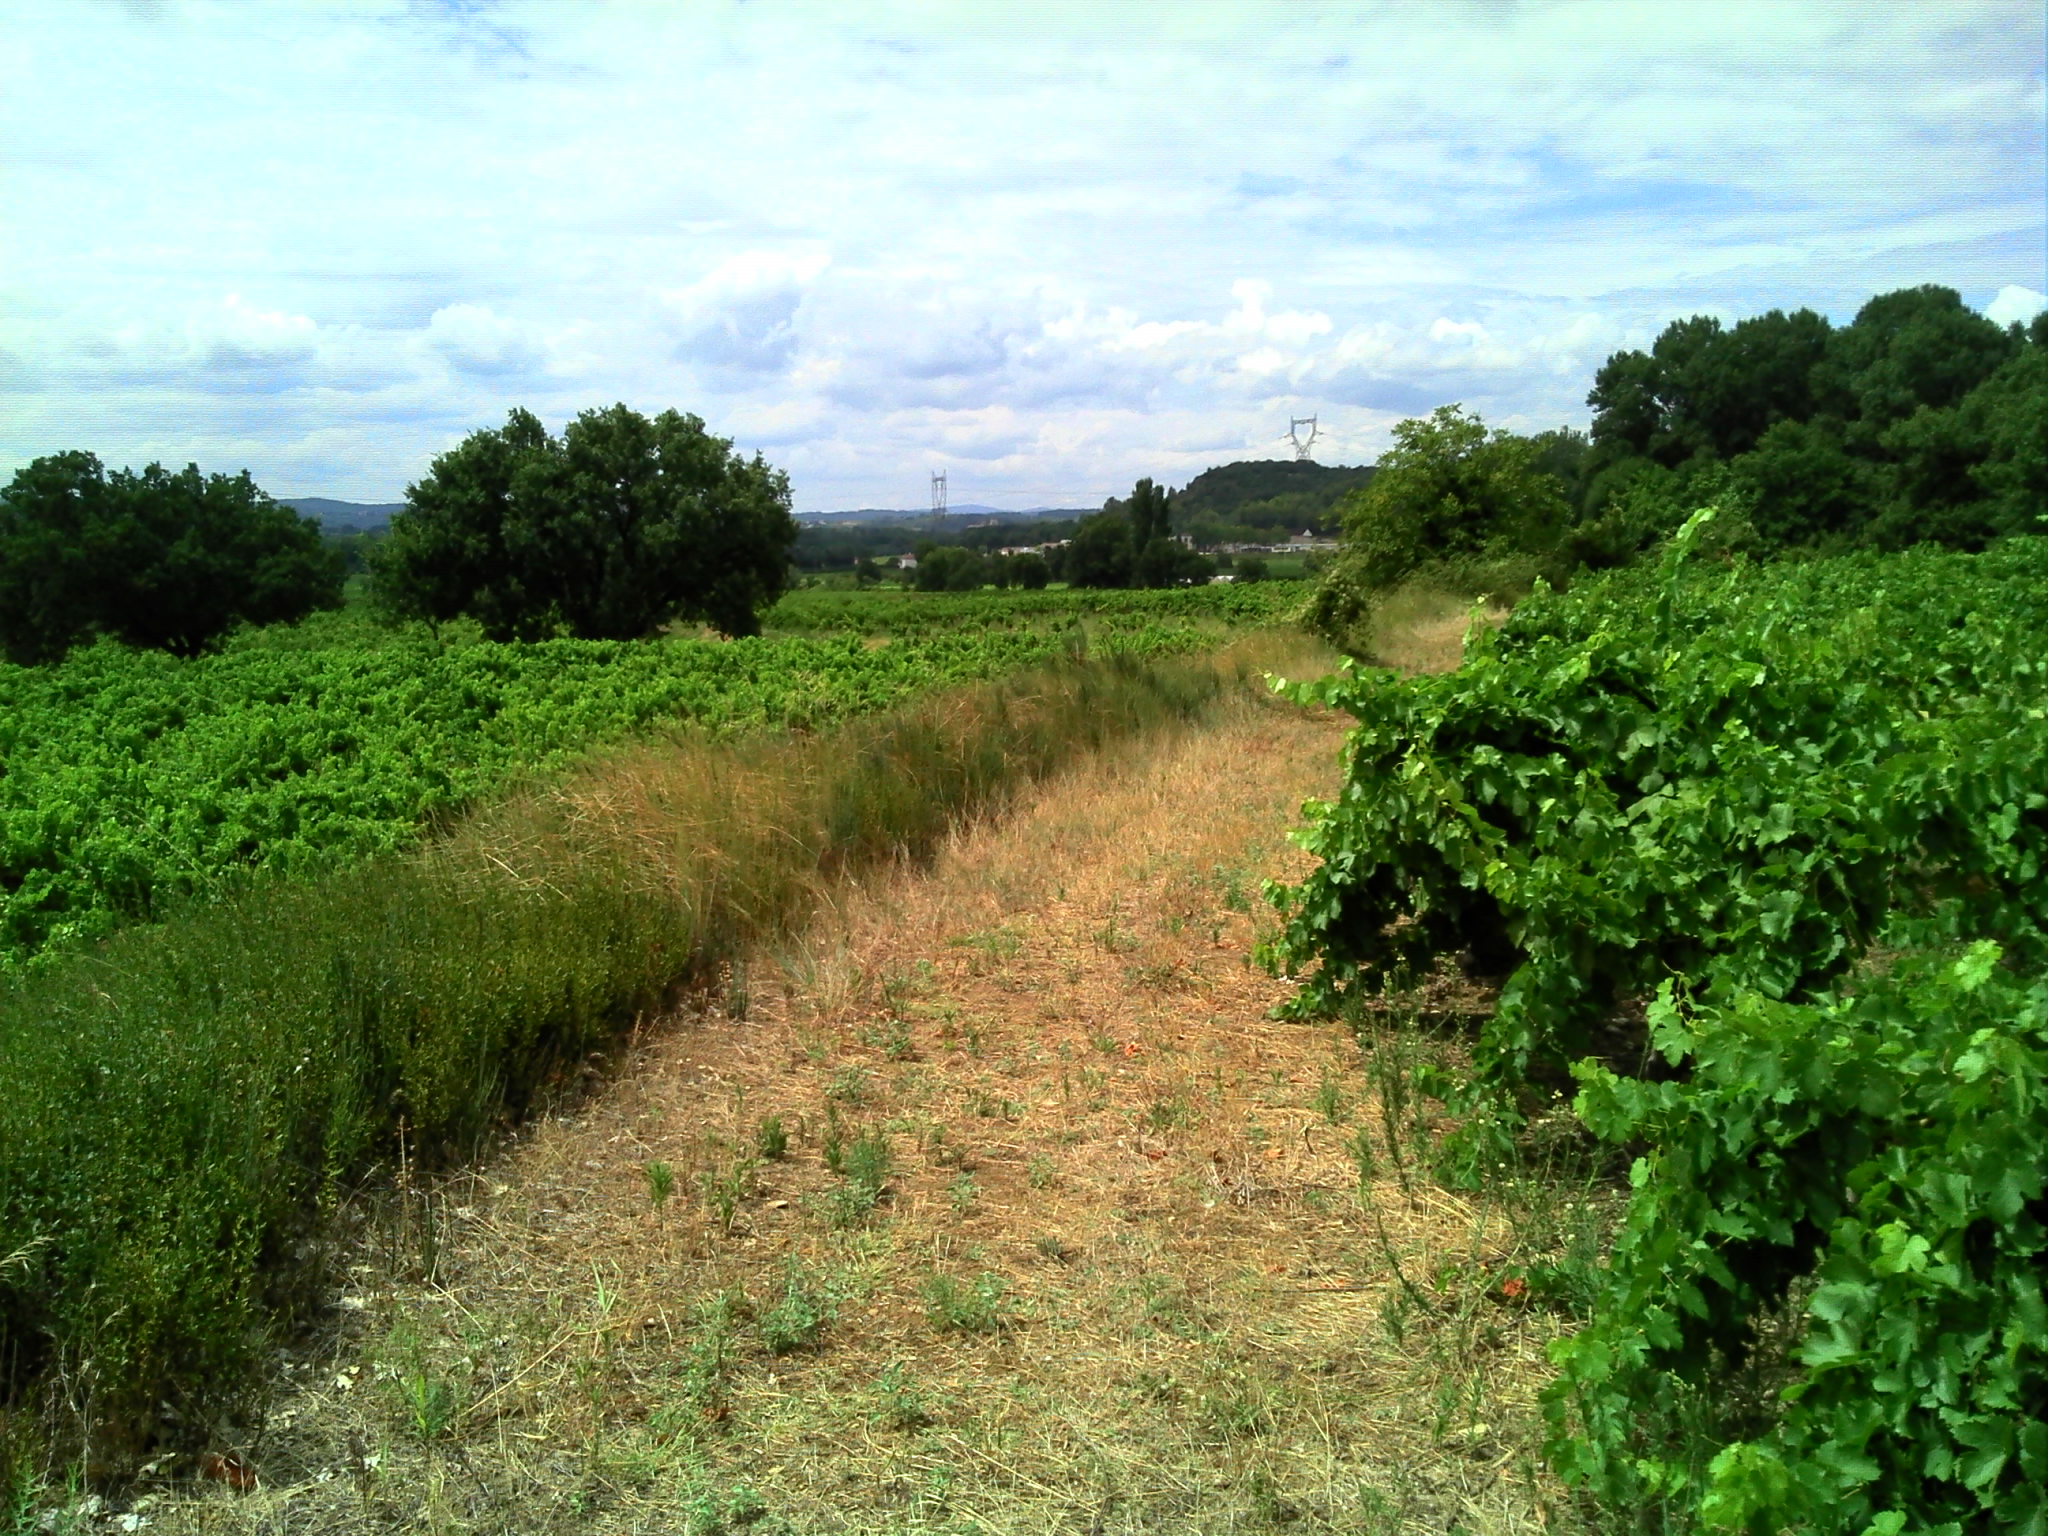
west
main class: Cropland
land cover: Vineyards
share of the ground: 10 - 25 %
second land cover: Spontaneously vegetated surfaces
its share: 50 - 75 %
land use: Agriculture (excluding fallow land and kitchen gardens)
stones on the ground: < 10 %
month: August
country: FR
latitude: 44.1028
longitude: 4.6238
